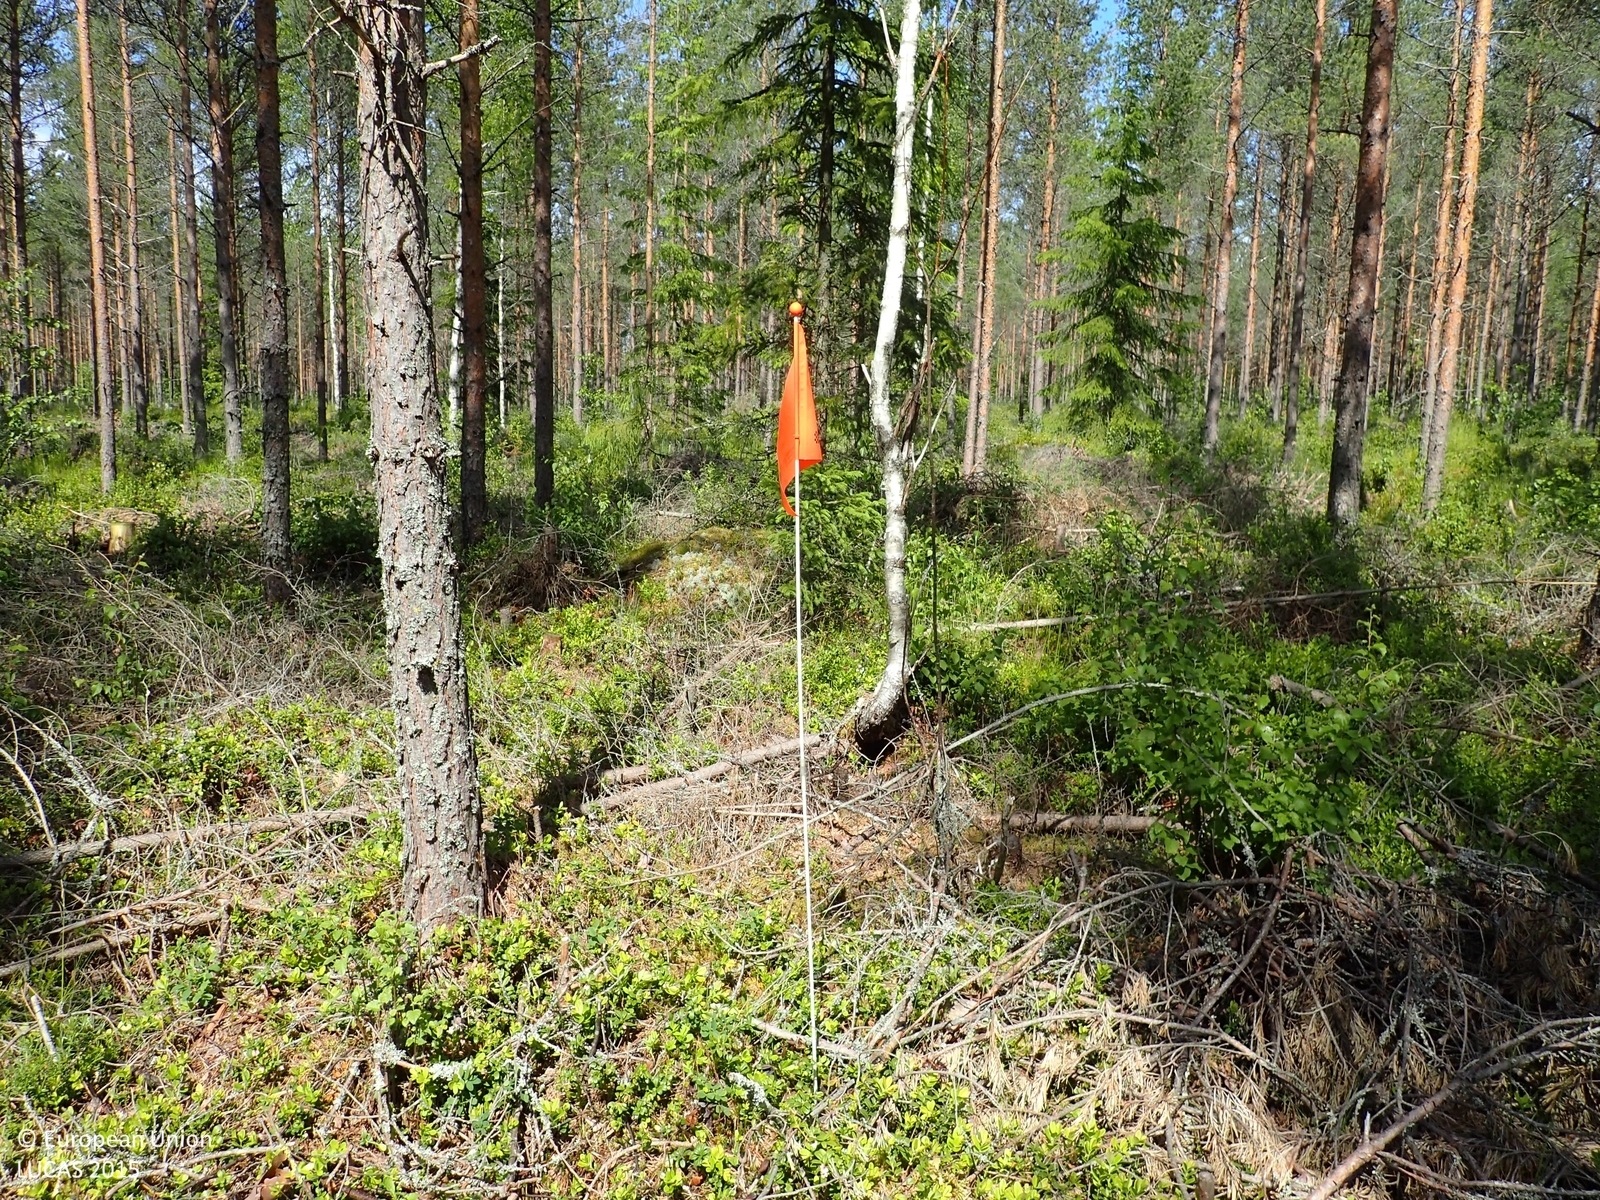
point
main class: Woodland
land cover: Pine dominated coniferous woodland
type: boreal forest
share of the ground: 50 - 75 %
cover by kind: coniferous forest trees 60 %, shrubs 30 %, broadleaved forest trees 5 %, herbaceous plants 5 %
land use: Forestry
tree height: > 5 m
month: June
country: FI
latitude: 62.4179
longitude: 21.6027
